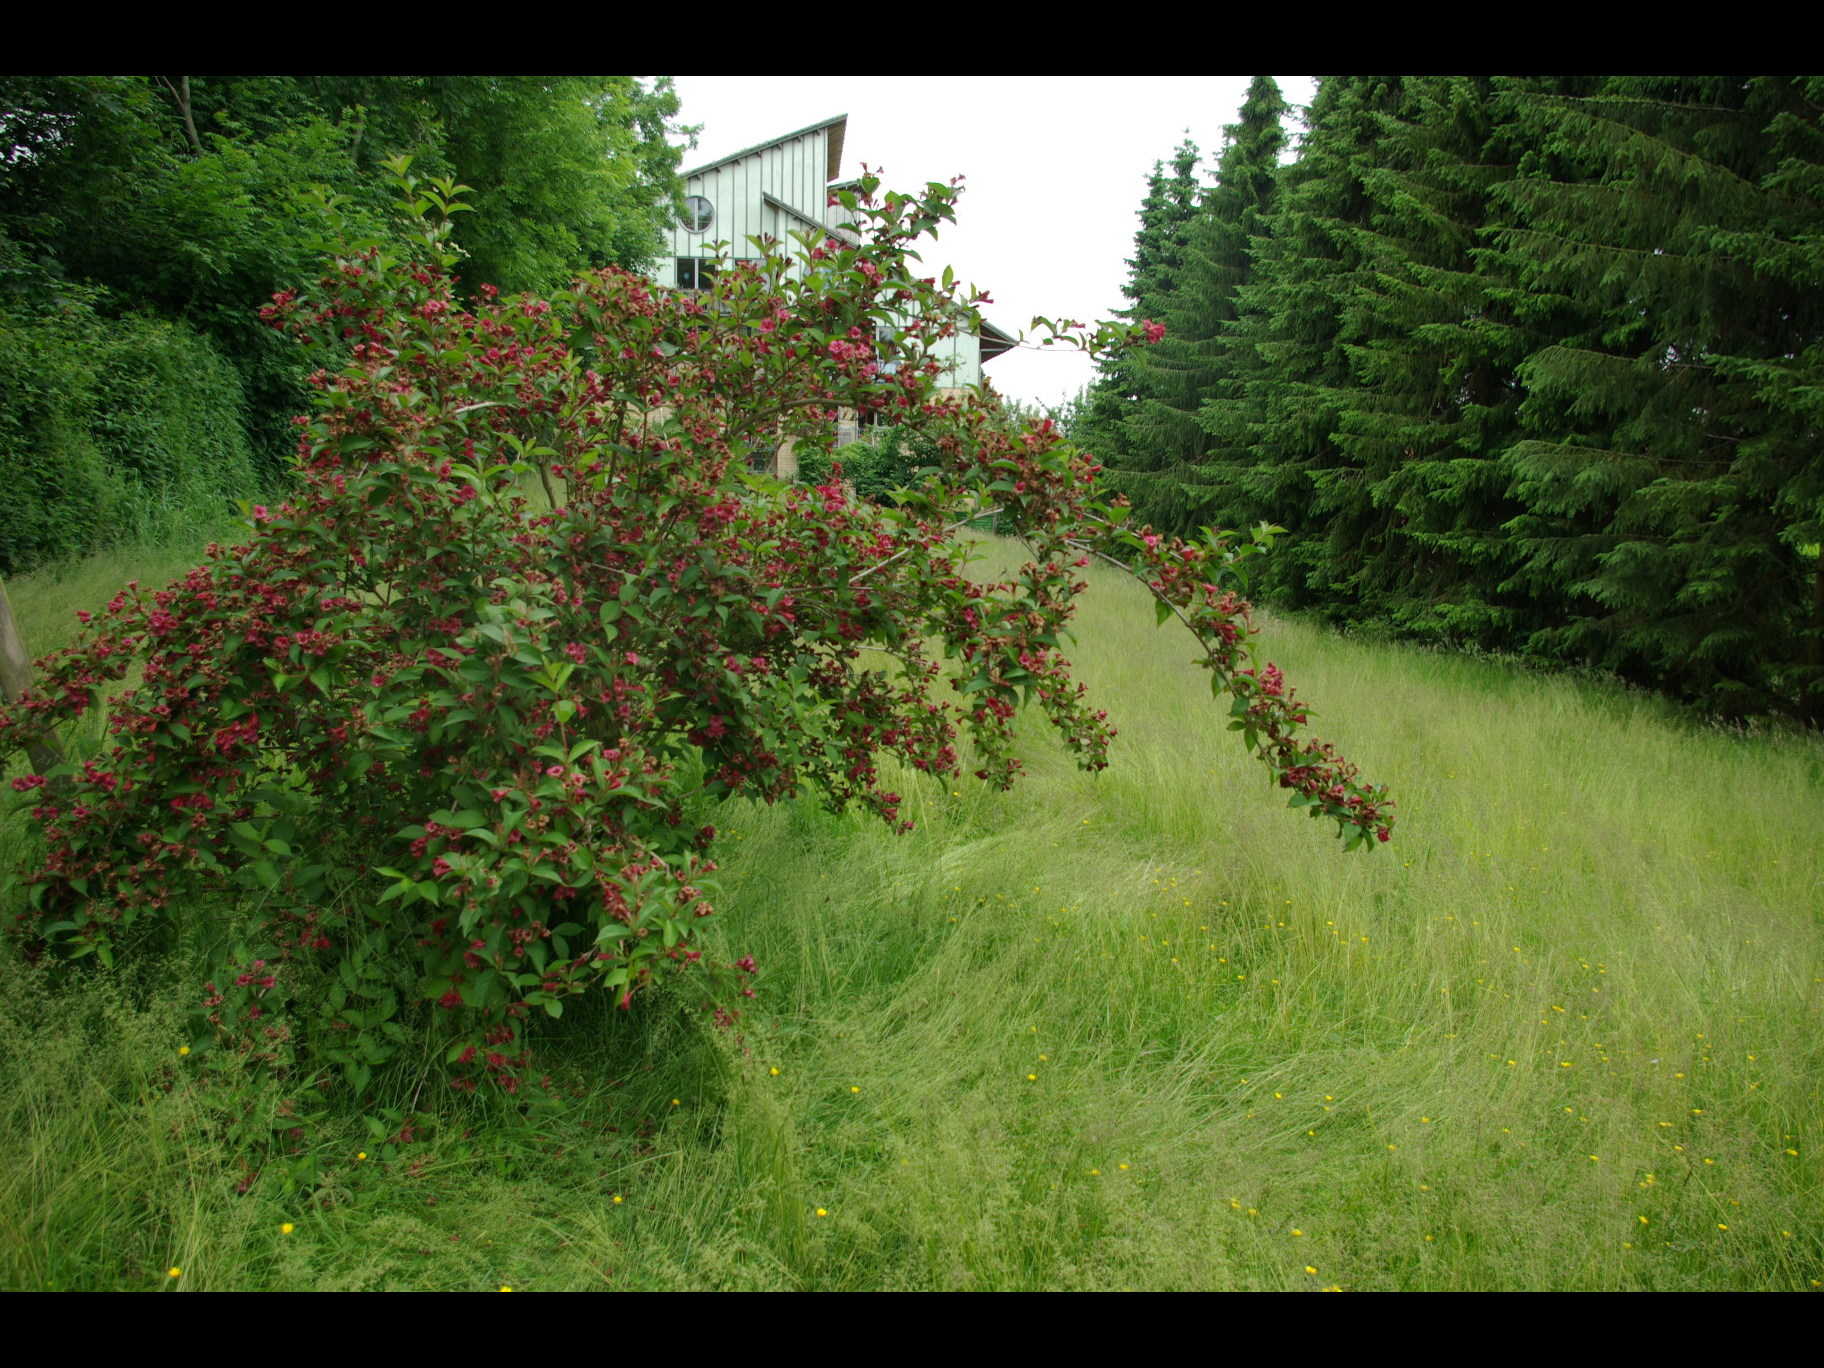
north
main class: Grassland
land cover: Grassland without tree/shrub cover
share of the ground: > 75 %
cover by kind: herbaceous plants 95 %, shrubs 5 %
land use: Residential
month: June
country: DE
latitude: 54.4622
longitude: 9.8304
